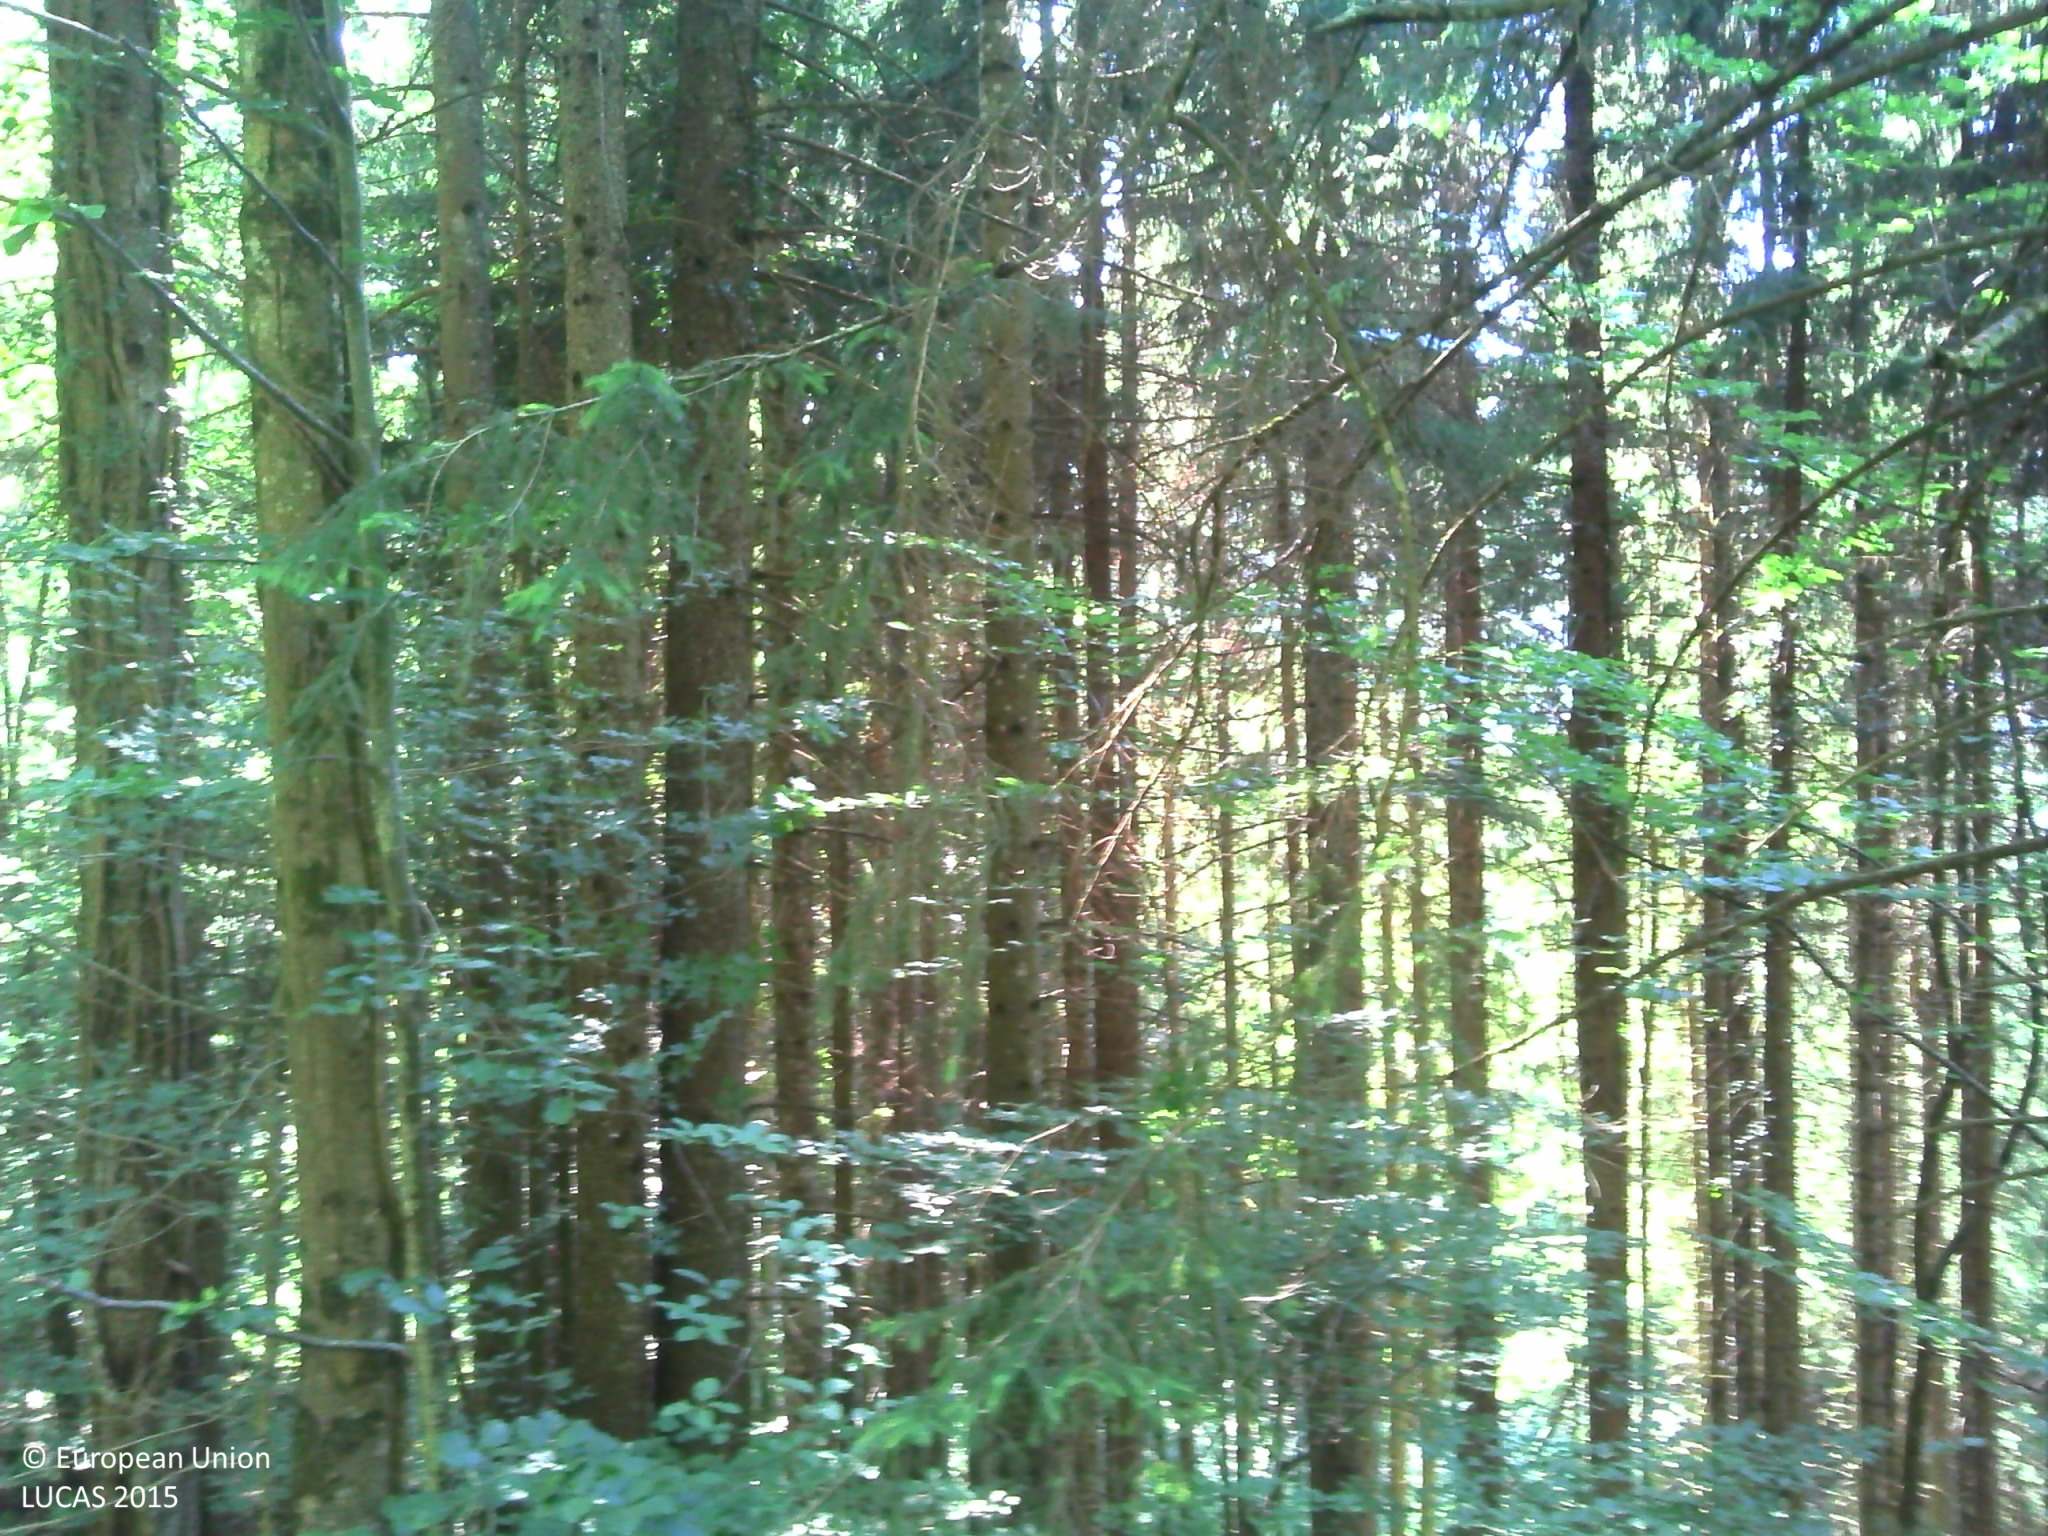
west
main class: Woodland
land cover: Spruce dominated coniferous woodland
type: hemiboreal forest and nemoral coniferous forest and mixed broadleaved-coniferous forest
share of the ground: > 75 %
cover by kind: coniferous forest trees 95 %, unconsolidated bare surface 5 %
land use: Forestry
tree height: > 5 m
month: June
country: FR
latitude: 45.0823
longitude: 5.4702
